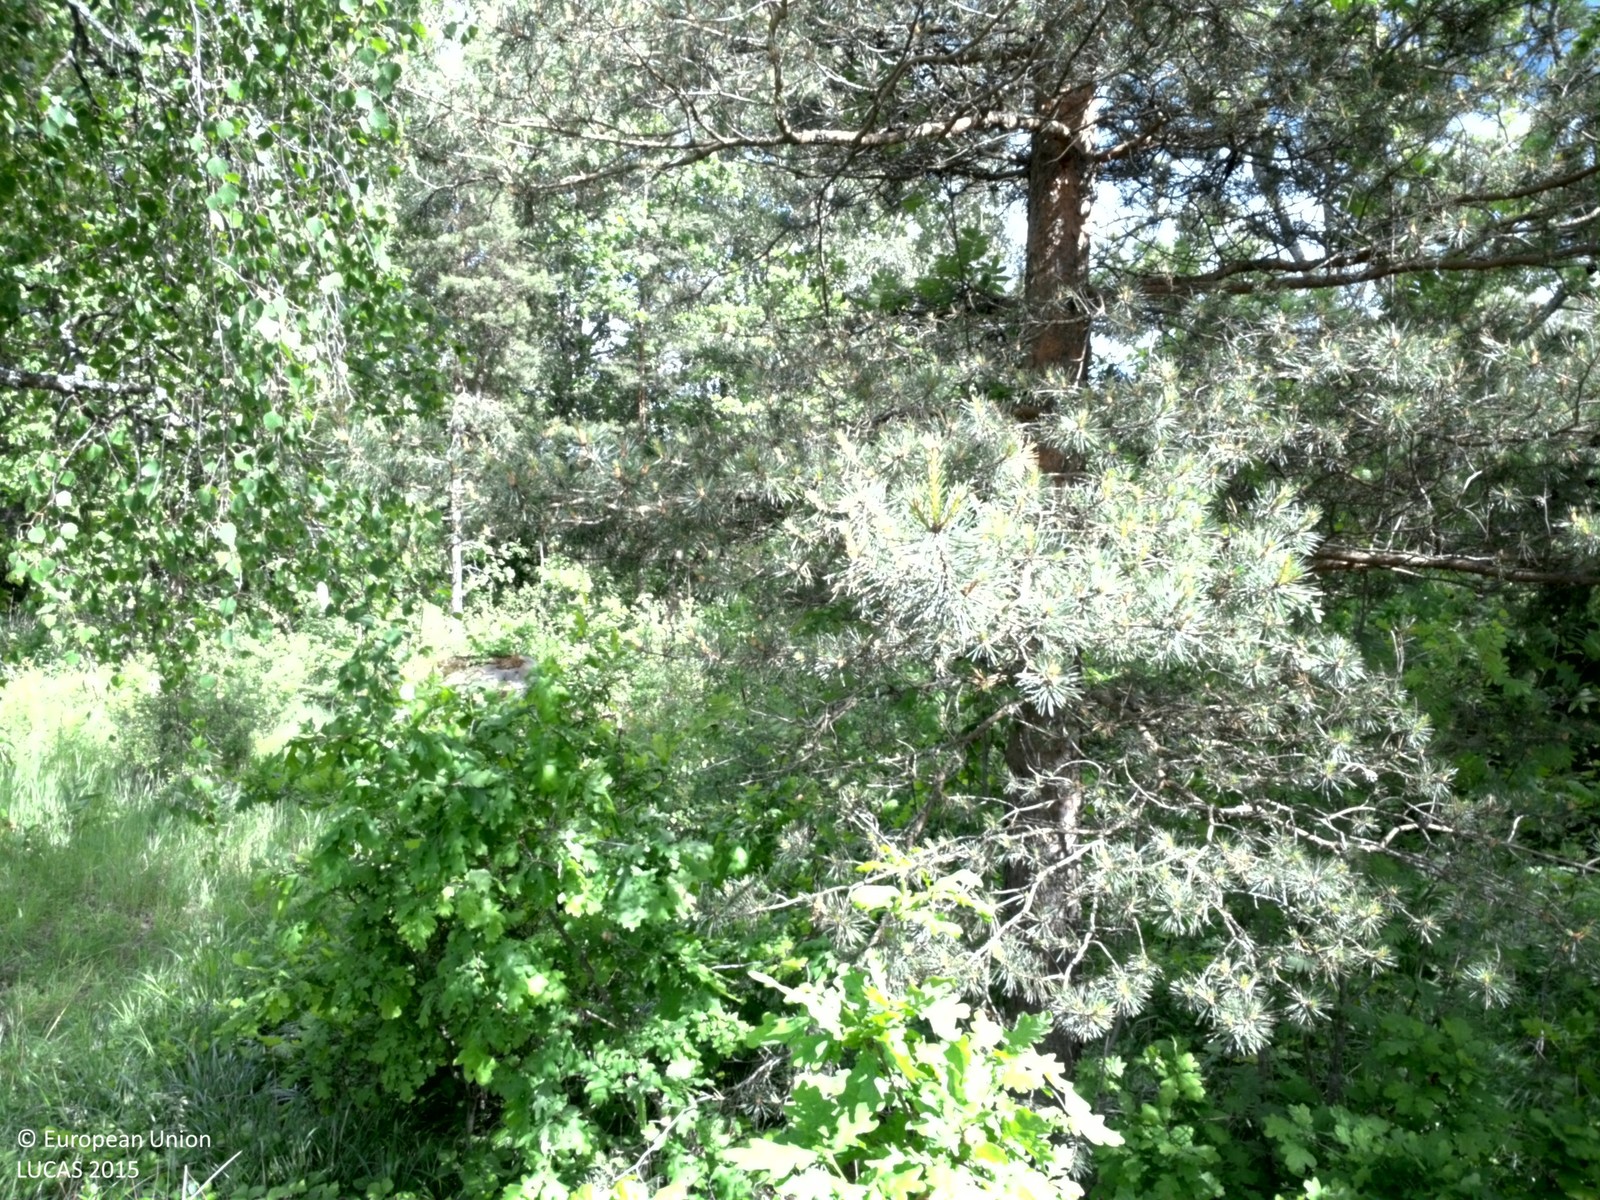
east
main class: Woodland
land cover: Broadleaved woodland
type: boreal forest
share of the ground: 25 - 50 %
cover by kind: broadleaved forest trees 40 %, herbaceous plants 30 %, coniferous forest trees 10 %, shrubs 10 %, lichens and mosses 10 %
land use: Forestry
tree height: > 5 m
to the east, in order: Broadleaved woodland; Common wheat; Grass margins; Ditches and canals; Single bushes/trees; Common wheat
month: June
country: SE
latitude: 59.8877
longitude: 17.5528
